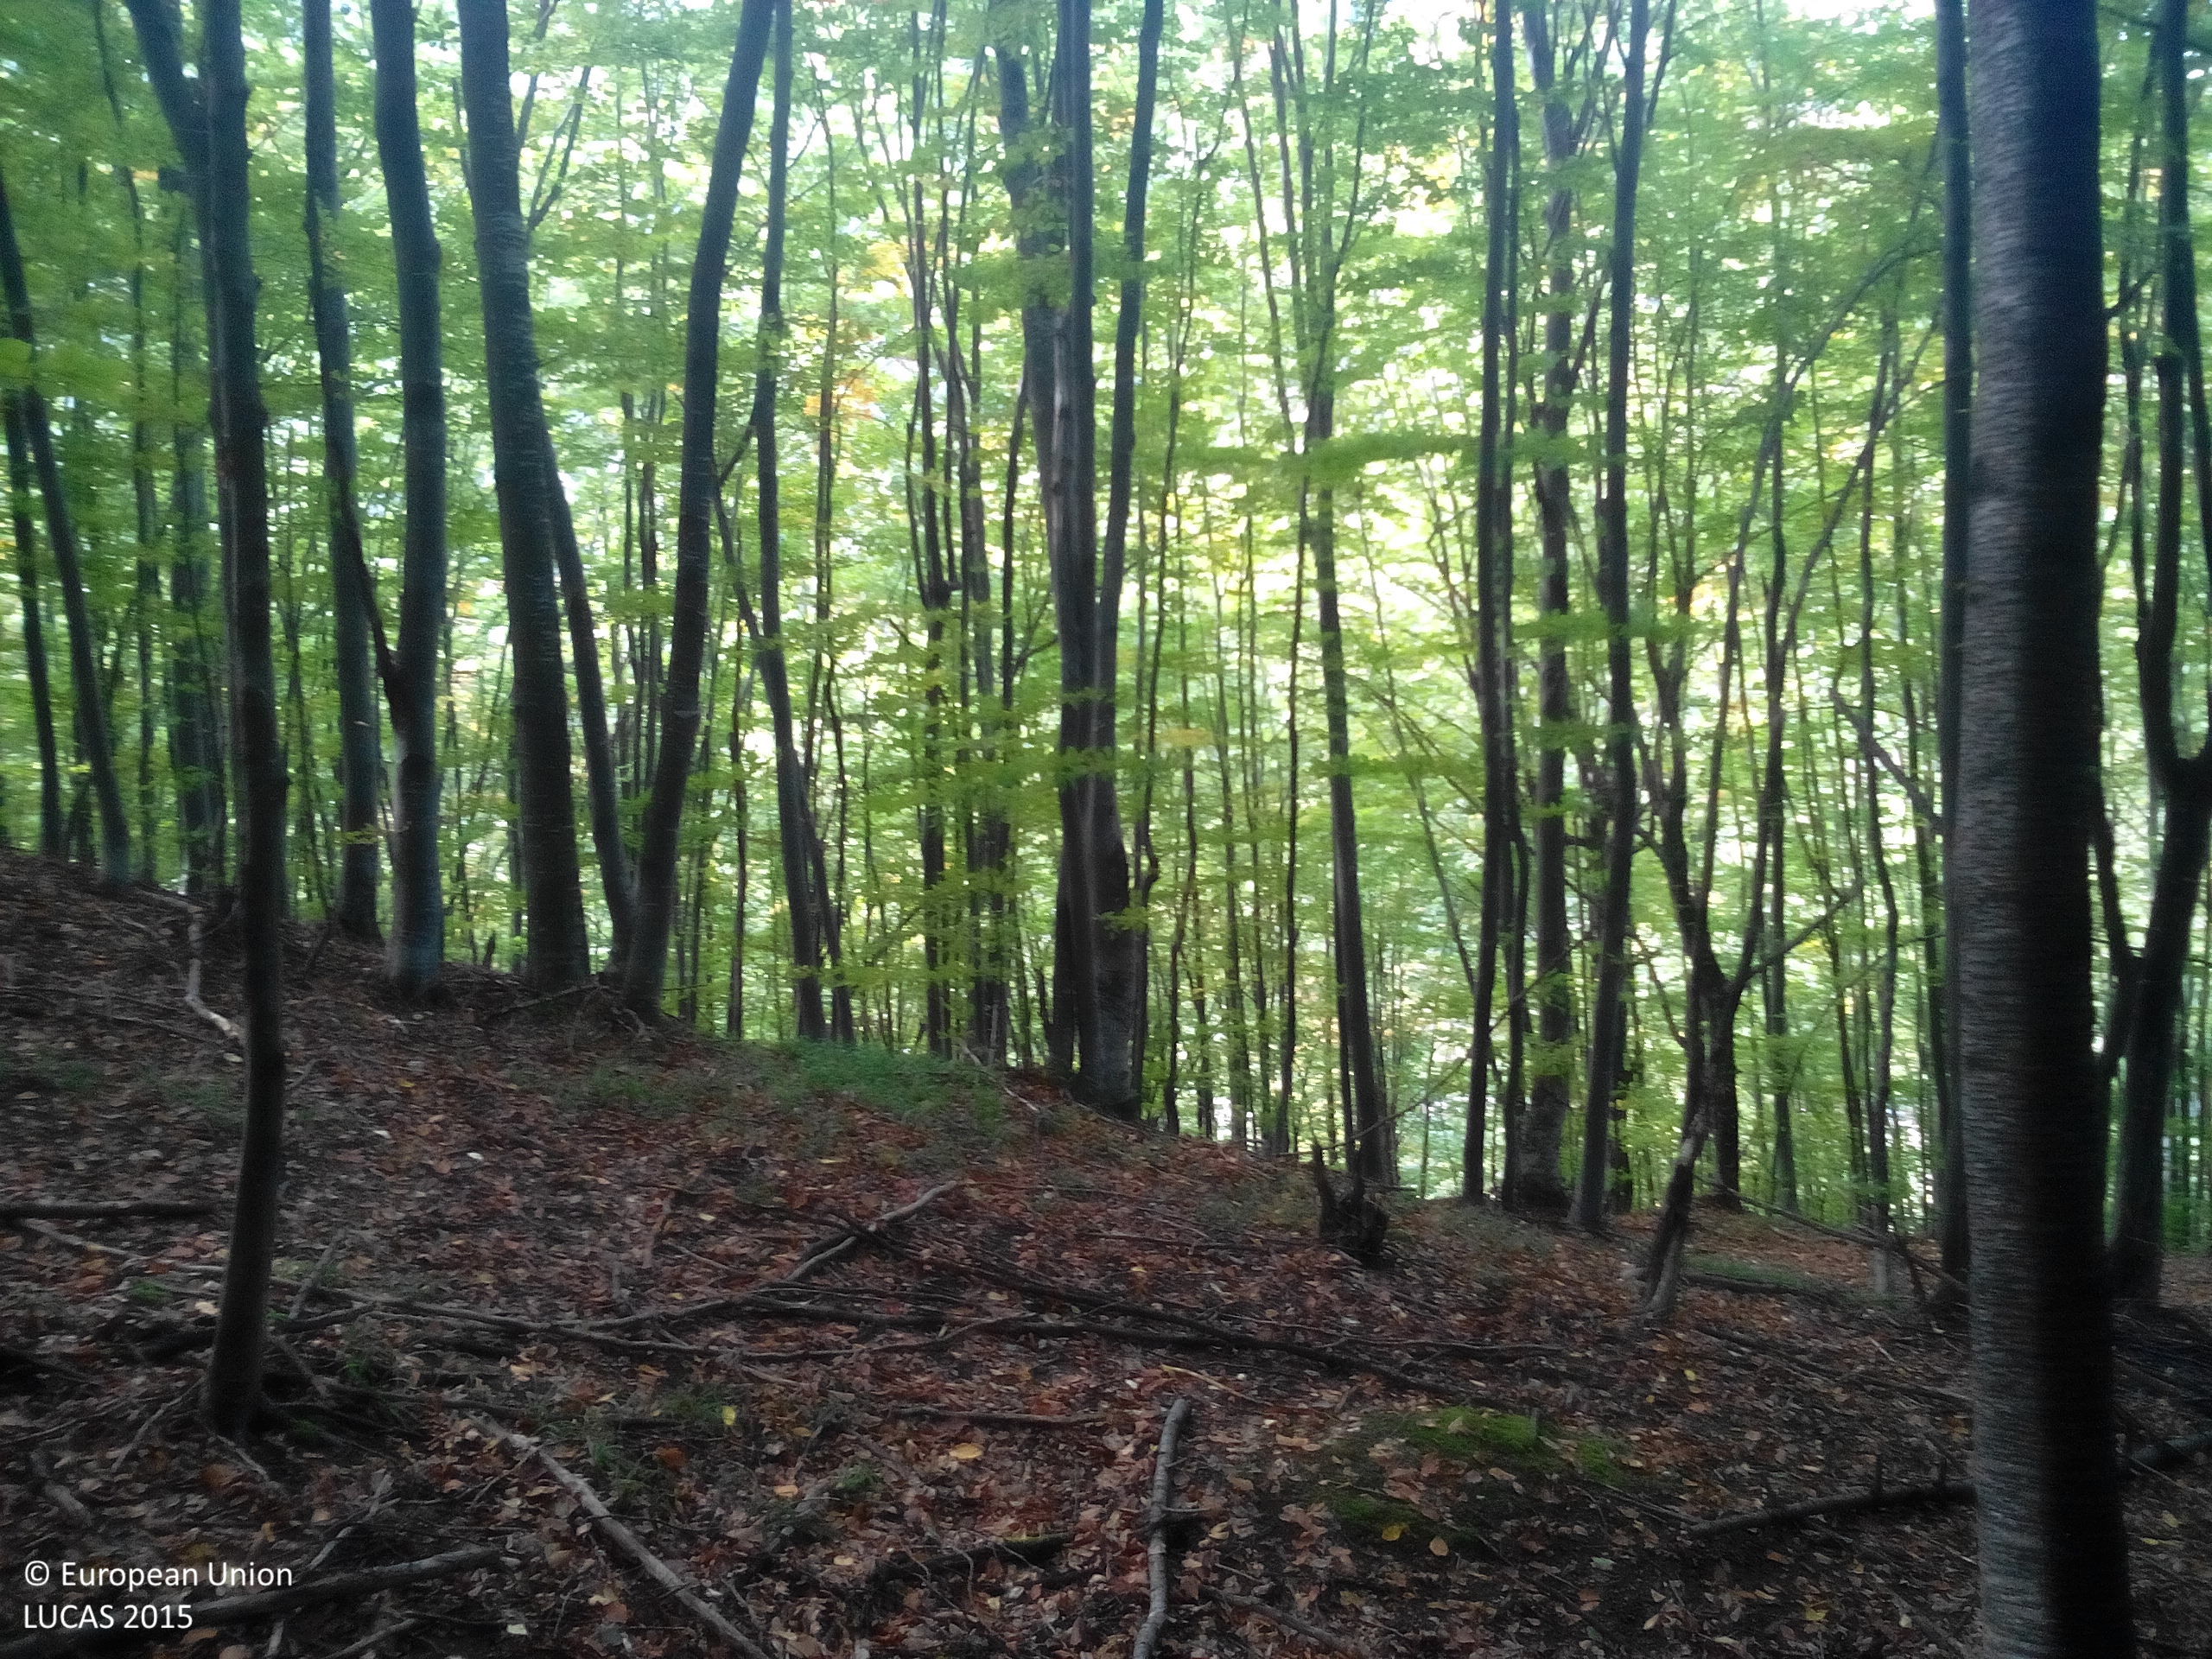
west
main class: Woodland
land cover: Broadleaved woodland
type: beech forest
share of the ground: > 75 %
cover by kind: broadleaved forest trees 100 %
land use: Forestry
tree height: > 5 m
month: October
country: BG
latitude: 42.8307
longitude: 24.3776
